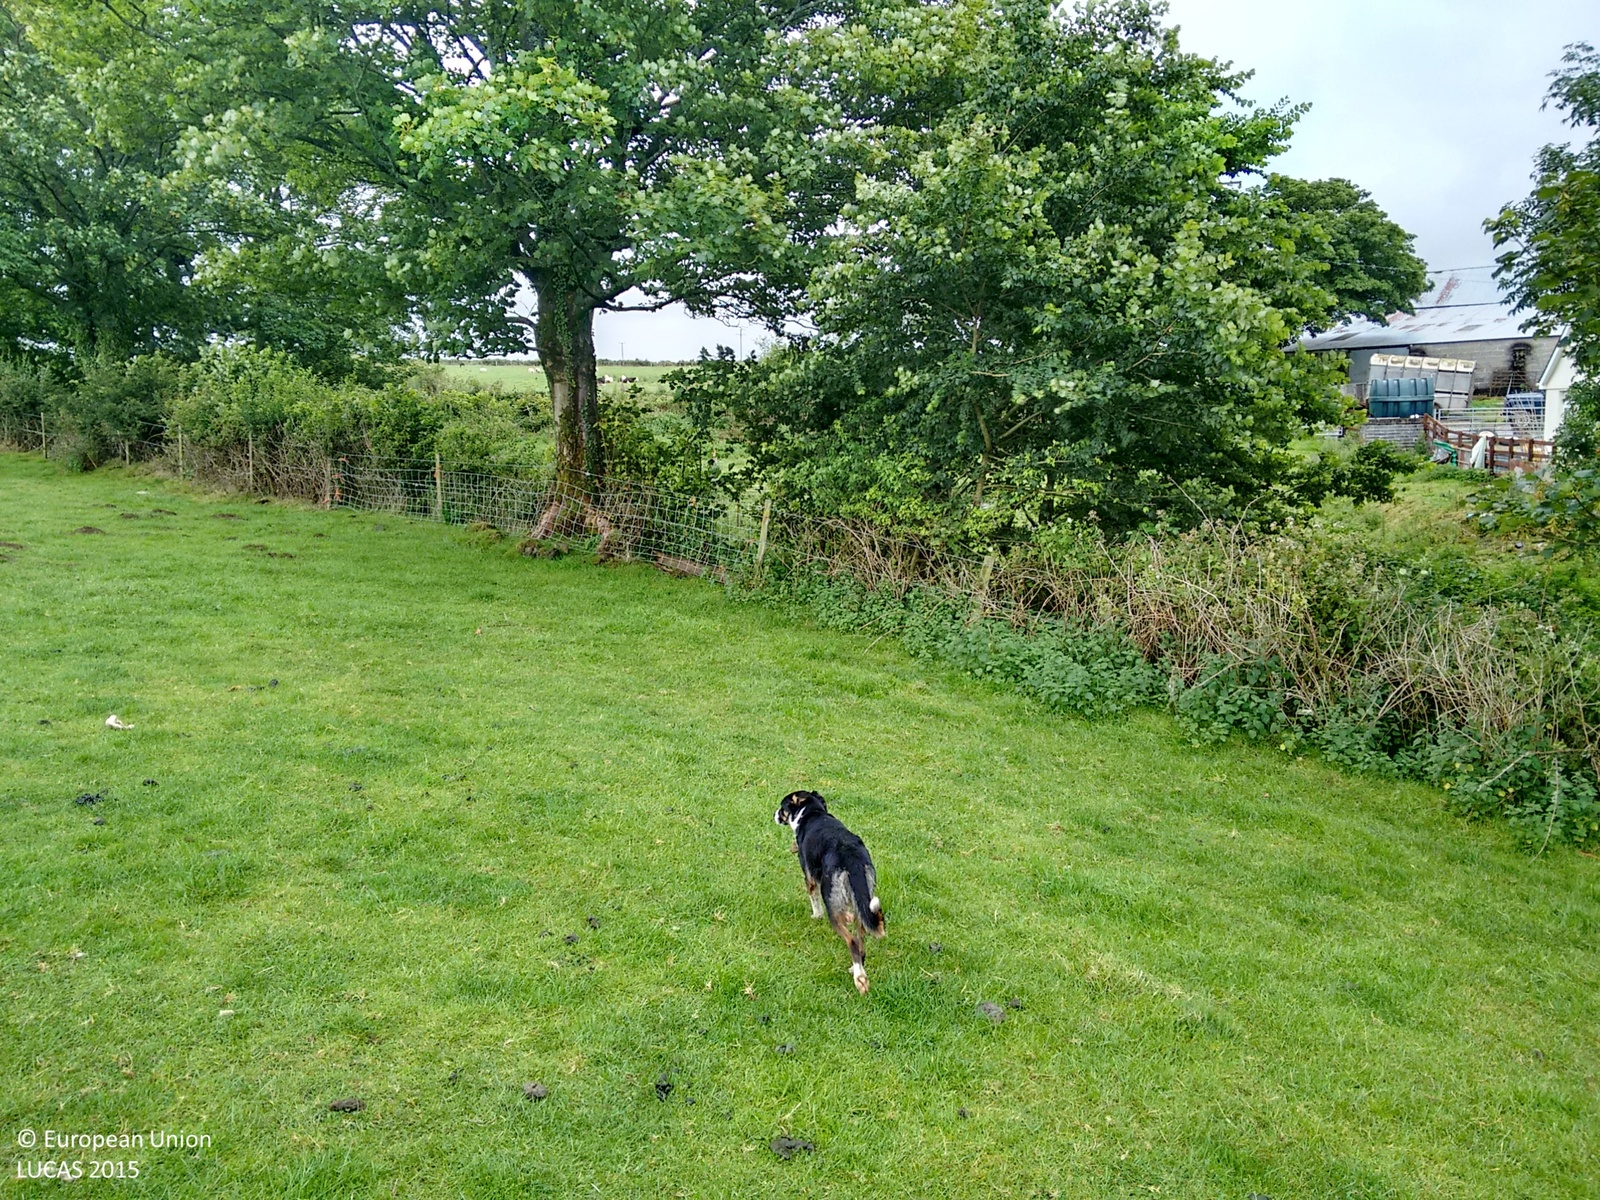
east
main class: Grassland
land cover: Grassland without tree/shrub cover
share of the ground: > 75 %
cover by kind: herbaceous plants 100 %
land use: Agriculture (excluding fallow land and kitchen gardens)
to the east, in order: Grassland without tree/shrub cover; Fences; Single bushes/trees; Grassland without tree/shrub cover; Managed hedges; Fences; Managed hedges; Tracks; Managed hedges; Fences; Grassland without tree/shrub cover
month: July
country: GB
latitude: 51.7133
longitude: -3.9444
